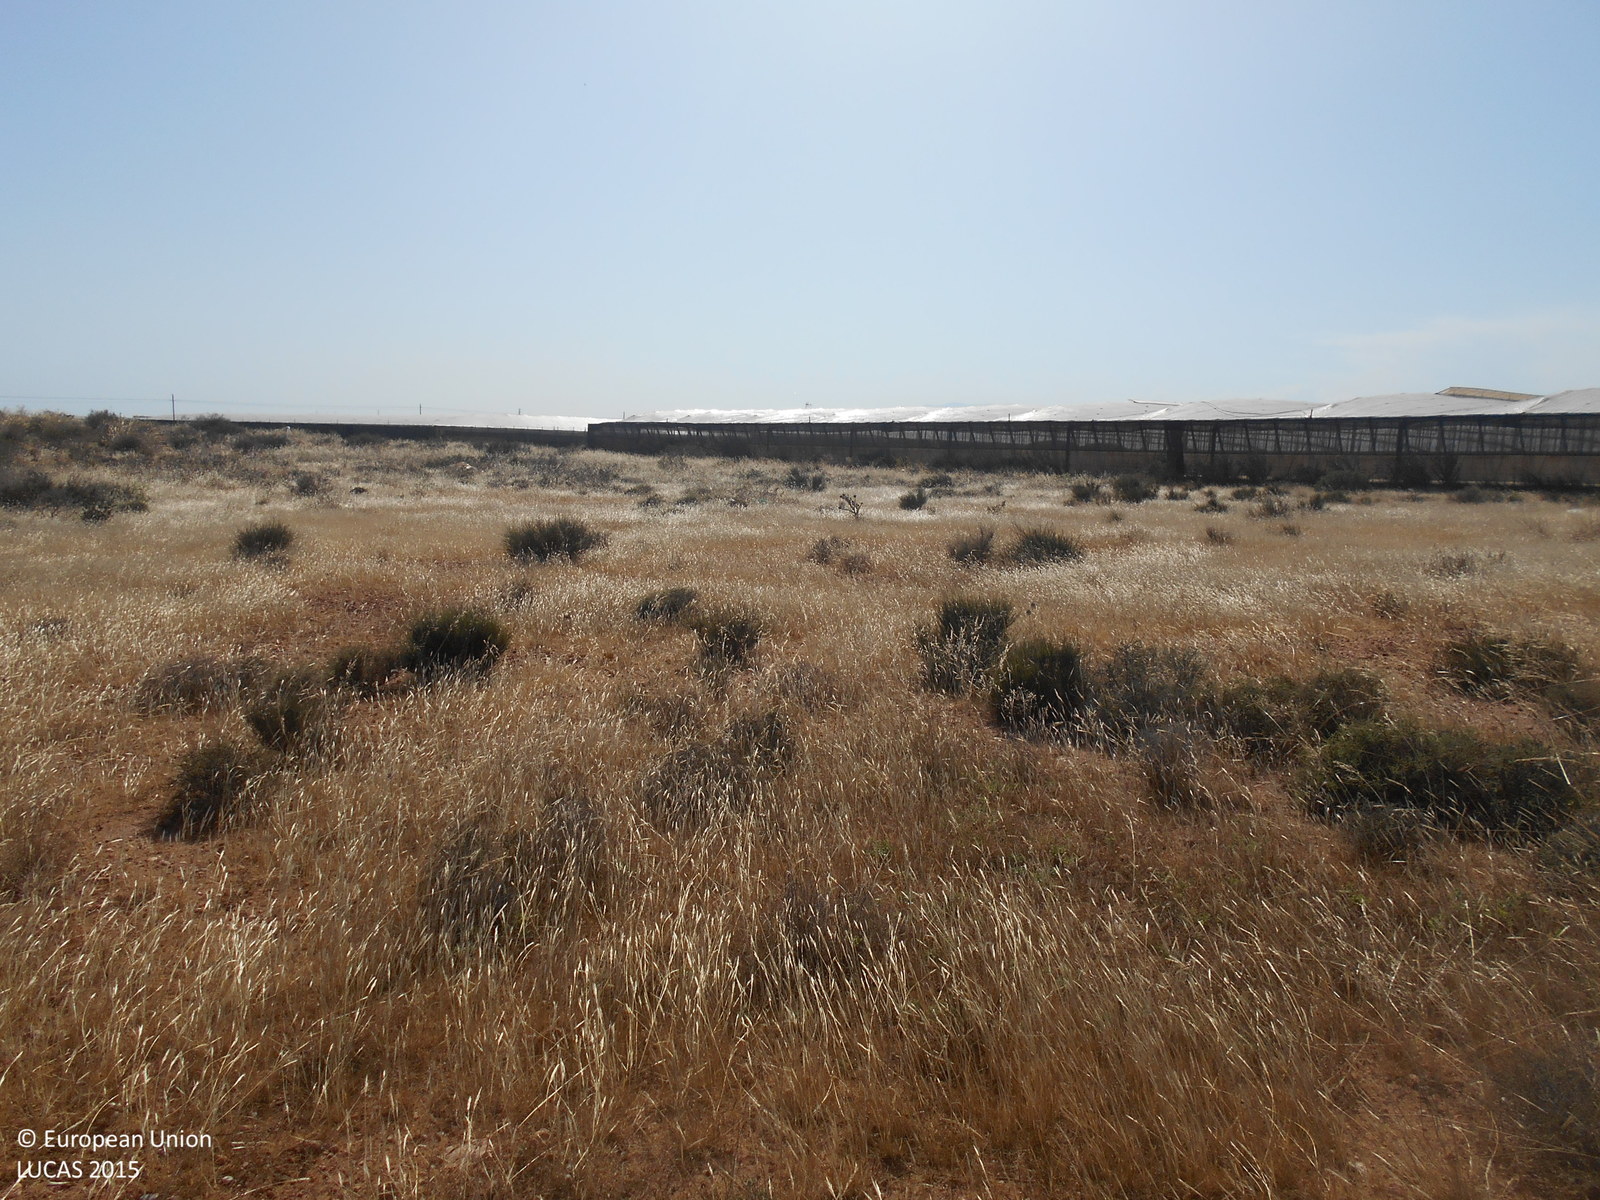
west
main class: Shrubland
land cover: Shrubland without tree cover
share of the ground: 10 - 25 %
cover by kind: herbaceous plants 40 %, unconsolidated bare surface 40 %, shrubs 20 %
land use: Semi-natural and natural areas not in use
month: May
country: ES
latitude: 36.8477
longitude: -2.2090
